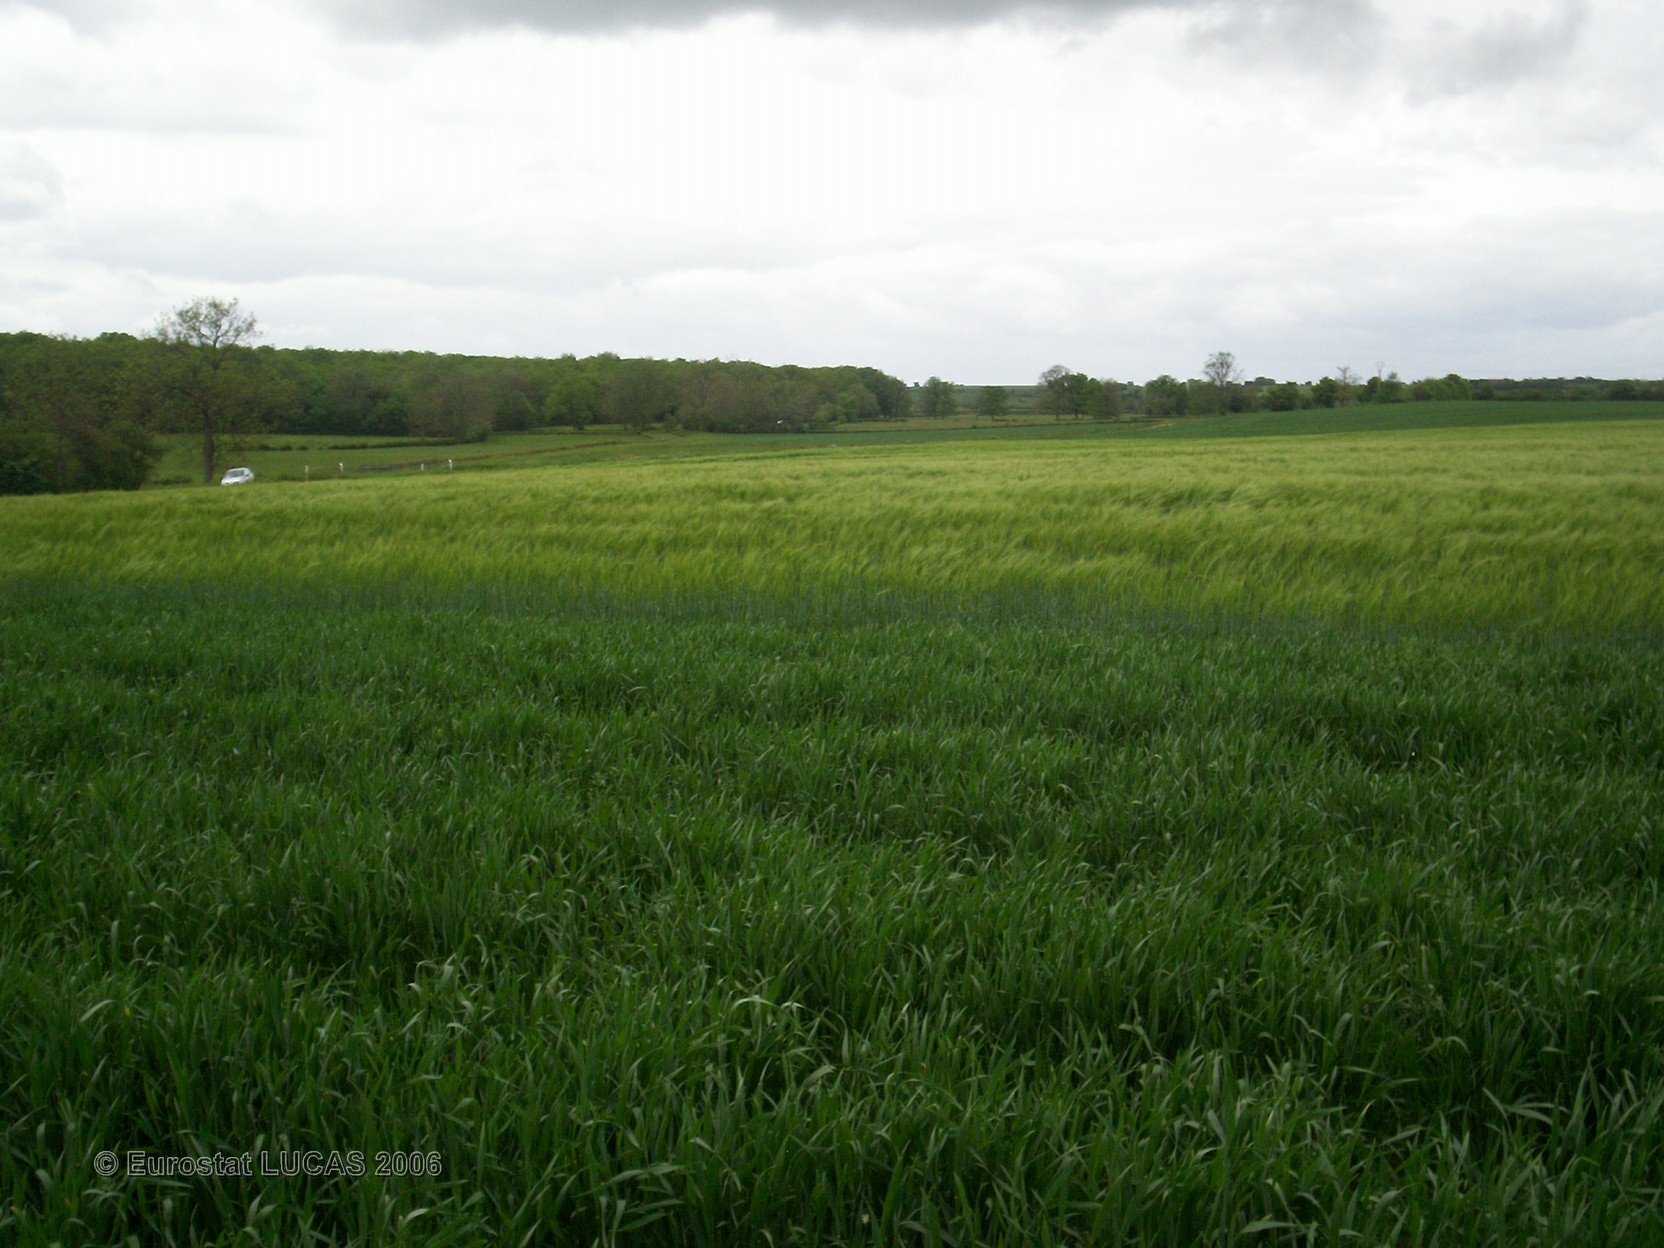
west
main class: Cropland
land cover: Common wheat
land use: Agriculture (excluding fallow land and kitchen gardens)
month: May
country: FR
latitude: 47.1535
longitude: 4.6058
